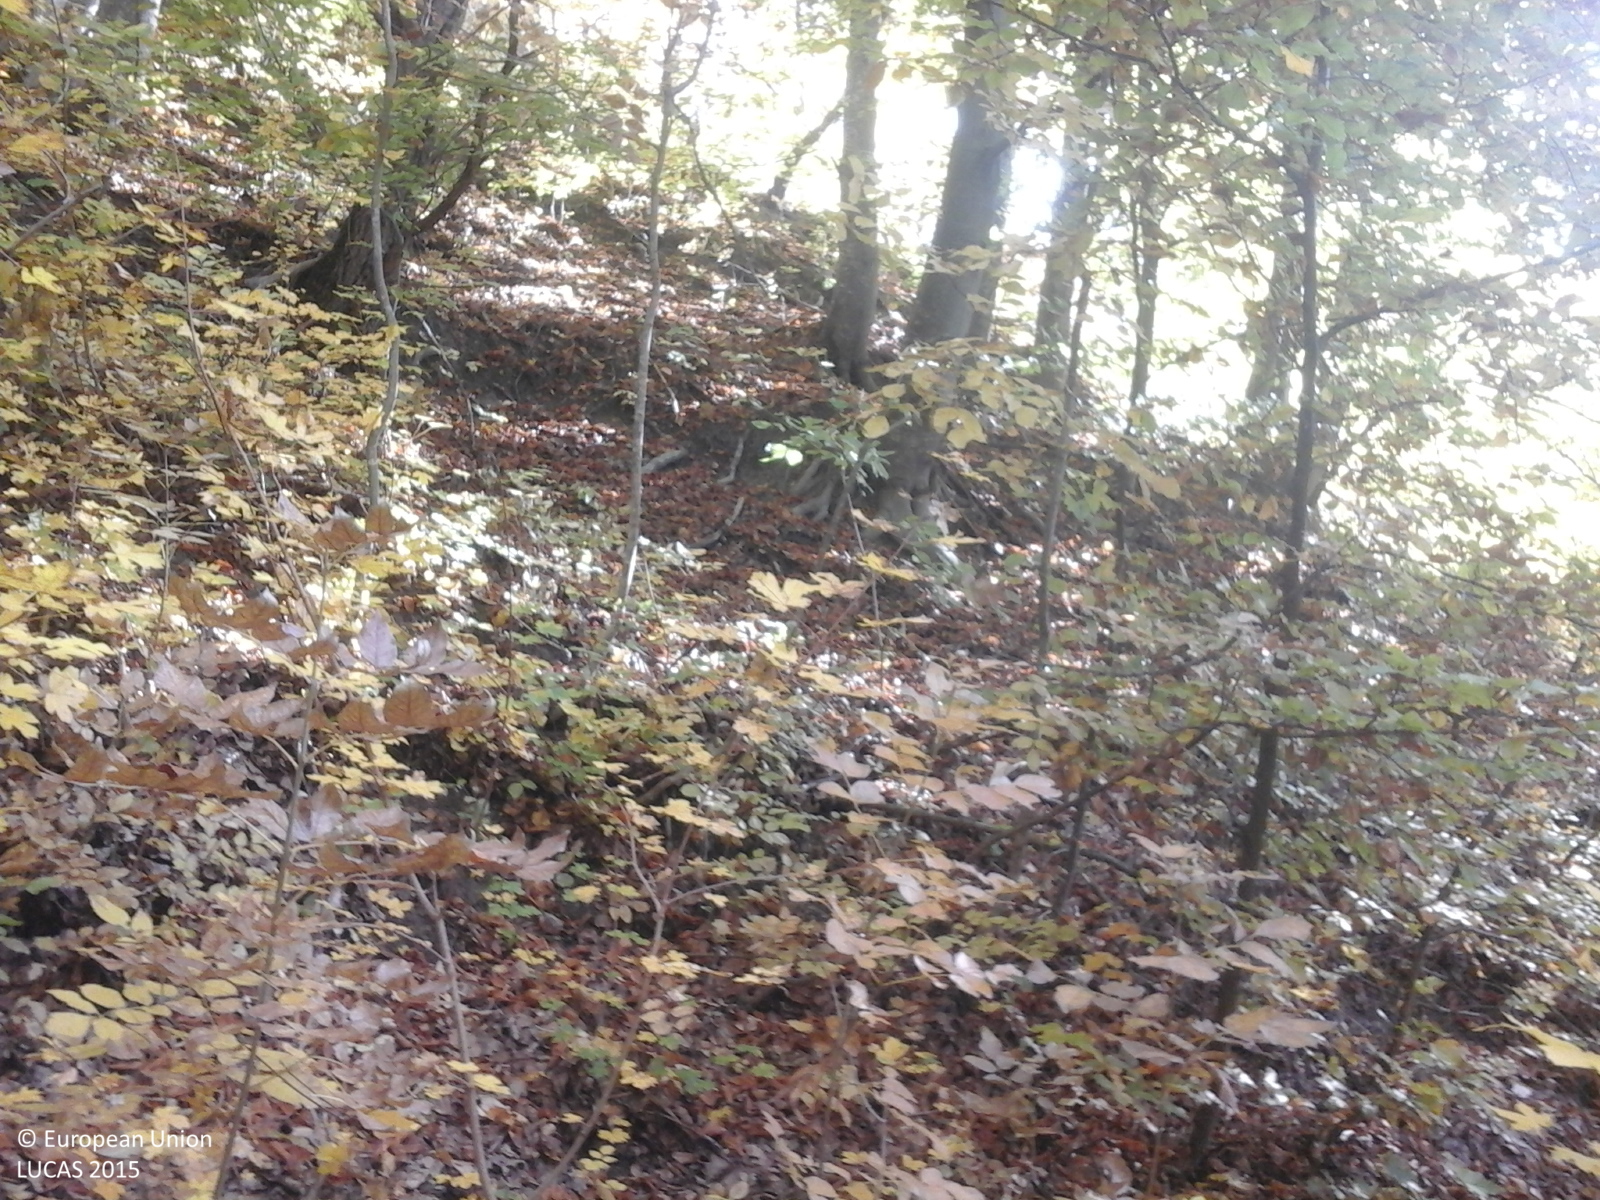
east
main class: Woodland
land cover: Broadleaved woodland
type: beech forest
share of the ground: > 75 %
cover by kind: broadleaved forest trees 100 %
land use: Forestry
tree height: > 5 m
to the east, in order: Broadleaved woodland; Tracks; Broadleaved woodland
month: October
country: RO
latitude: 45.6810
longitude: 26.9717
